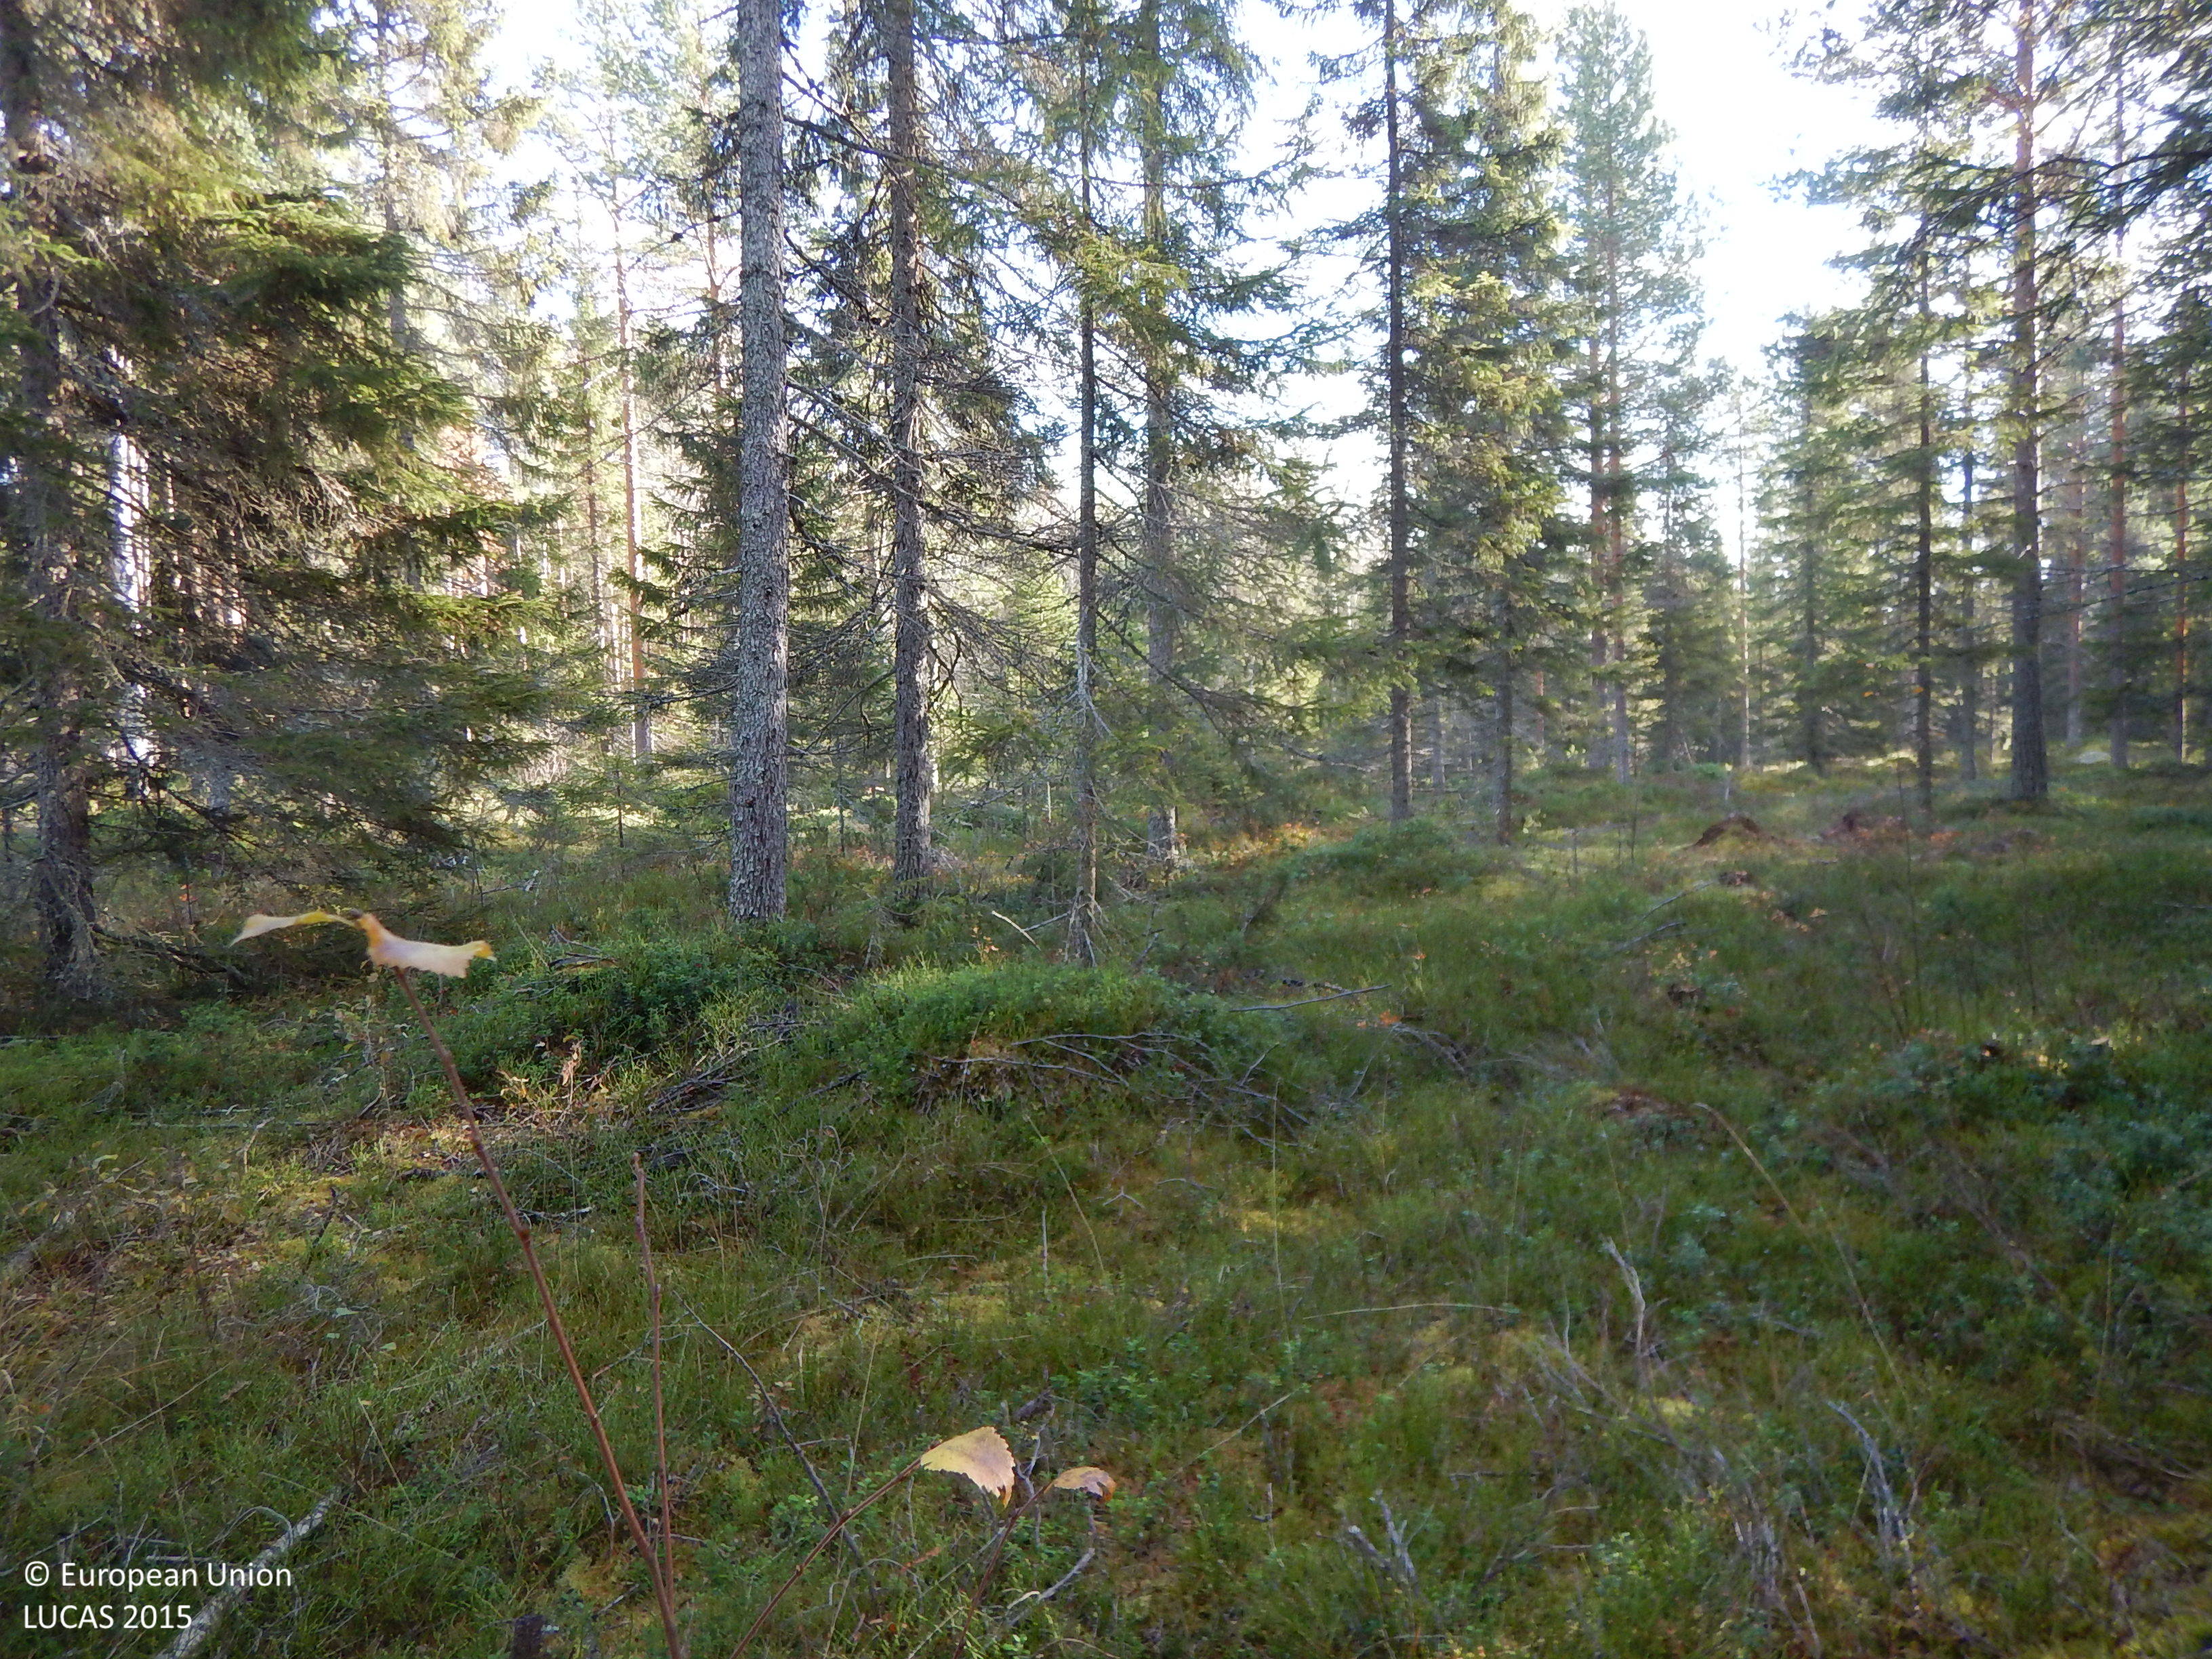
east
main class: Woodland
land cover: Other coniferous woodland
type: boreal forest
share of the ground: 50 - 75 %
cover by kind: coniferous forest trees 70 %, shrubs 15 %, lichens and mosses 10 %, herbaceous plants 5 %
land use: Forestry
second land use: Amenities, museums, leisure
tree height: > 5 m
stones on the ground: < 10 %
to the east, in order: Other coniferous woodland; Rivers and streams; Pine dominated coniferous woodland; Rivers and streams; Spruce dominated coniferous woodland; Other coniferous woodland
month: October
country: SE
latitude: 64.9672
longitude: 20.9686
